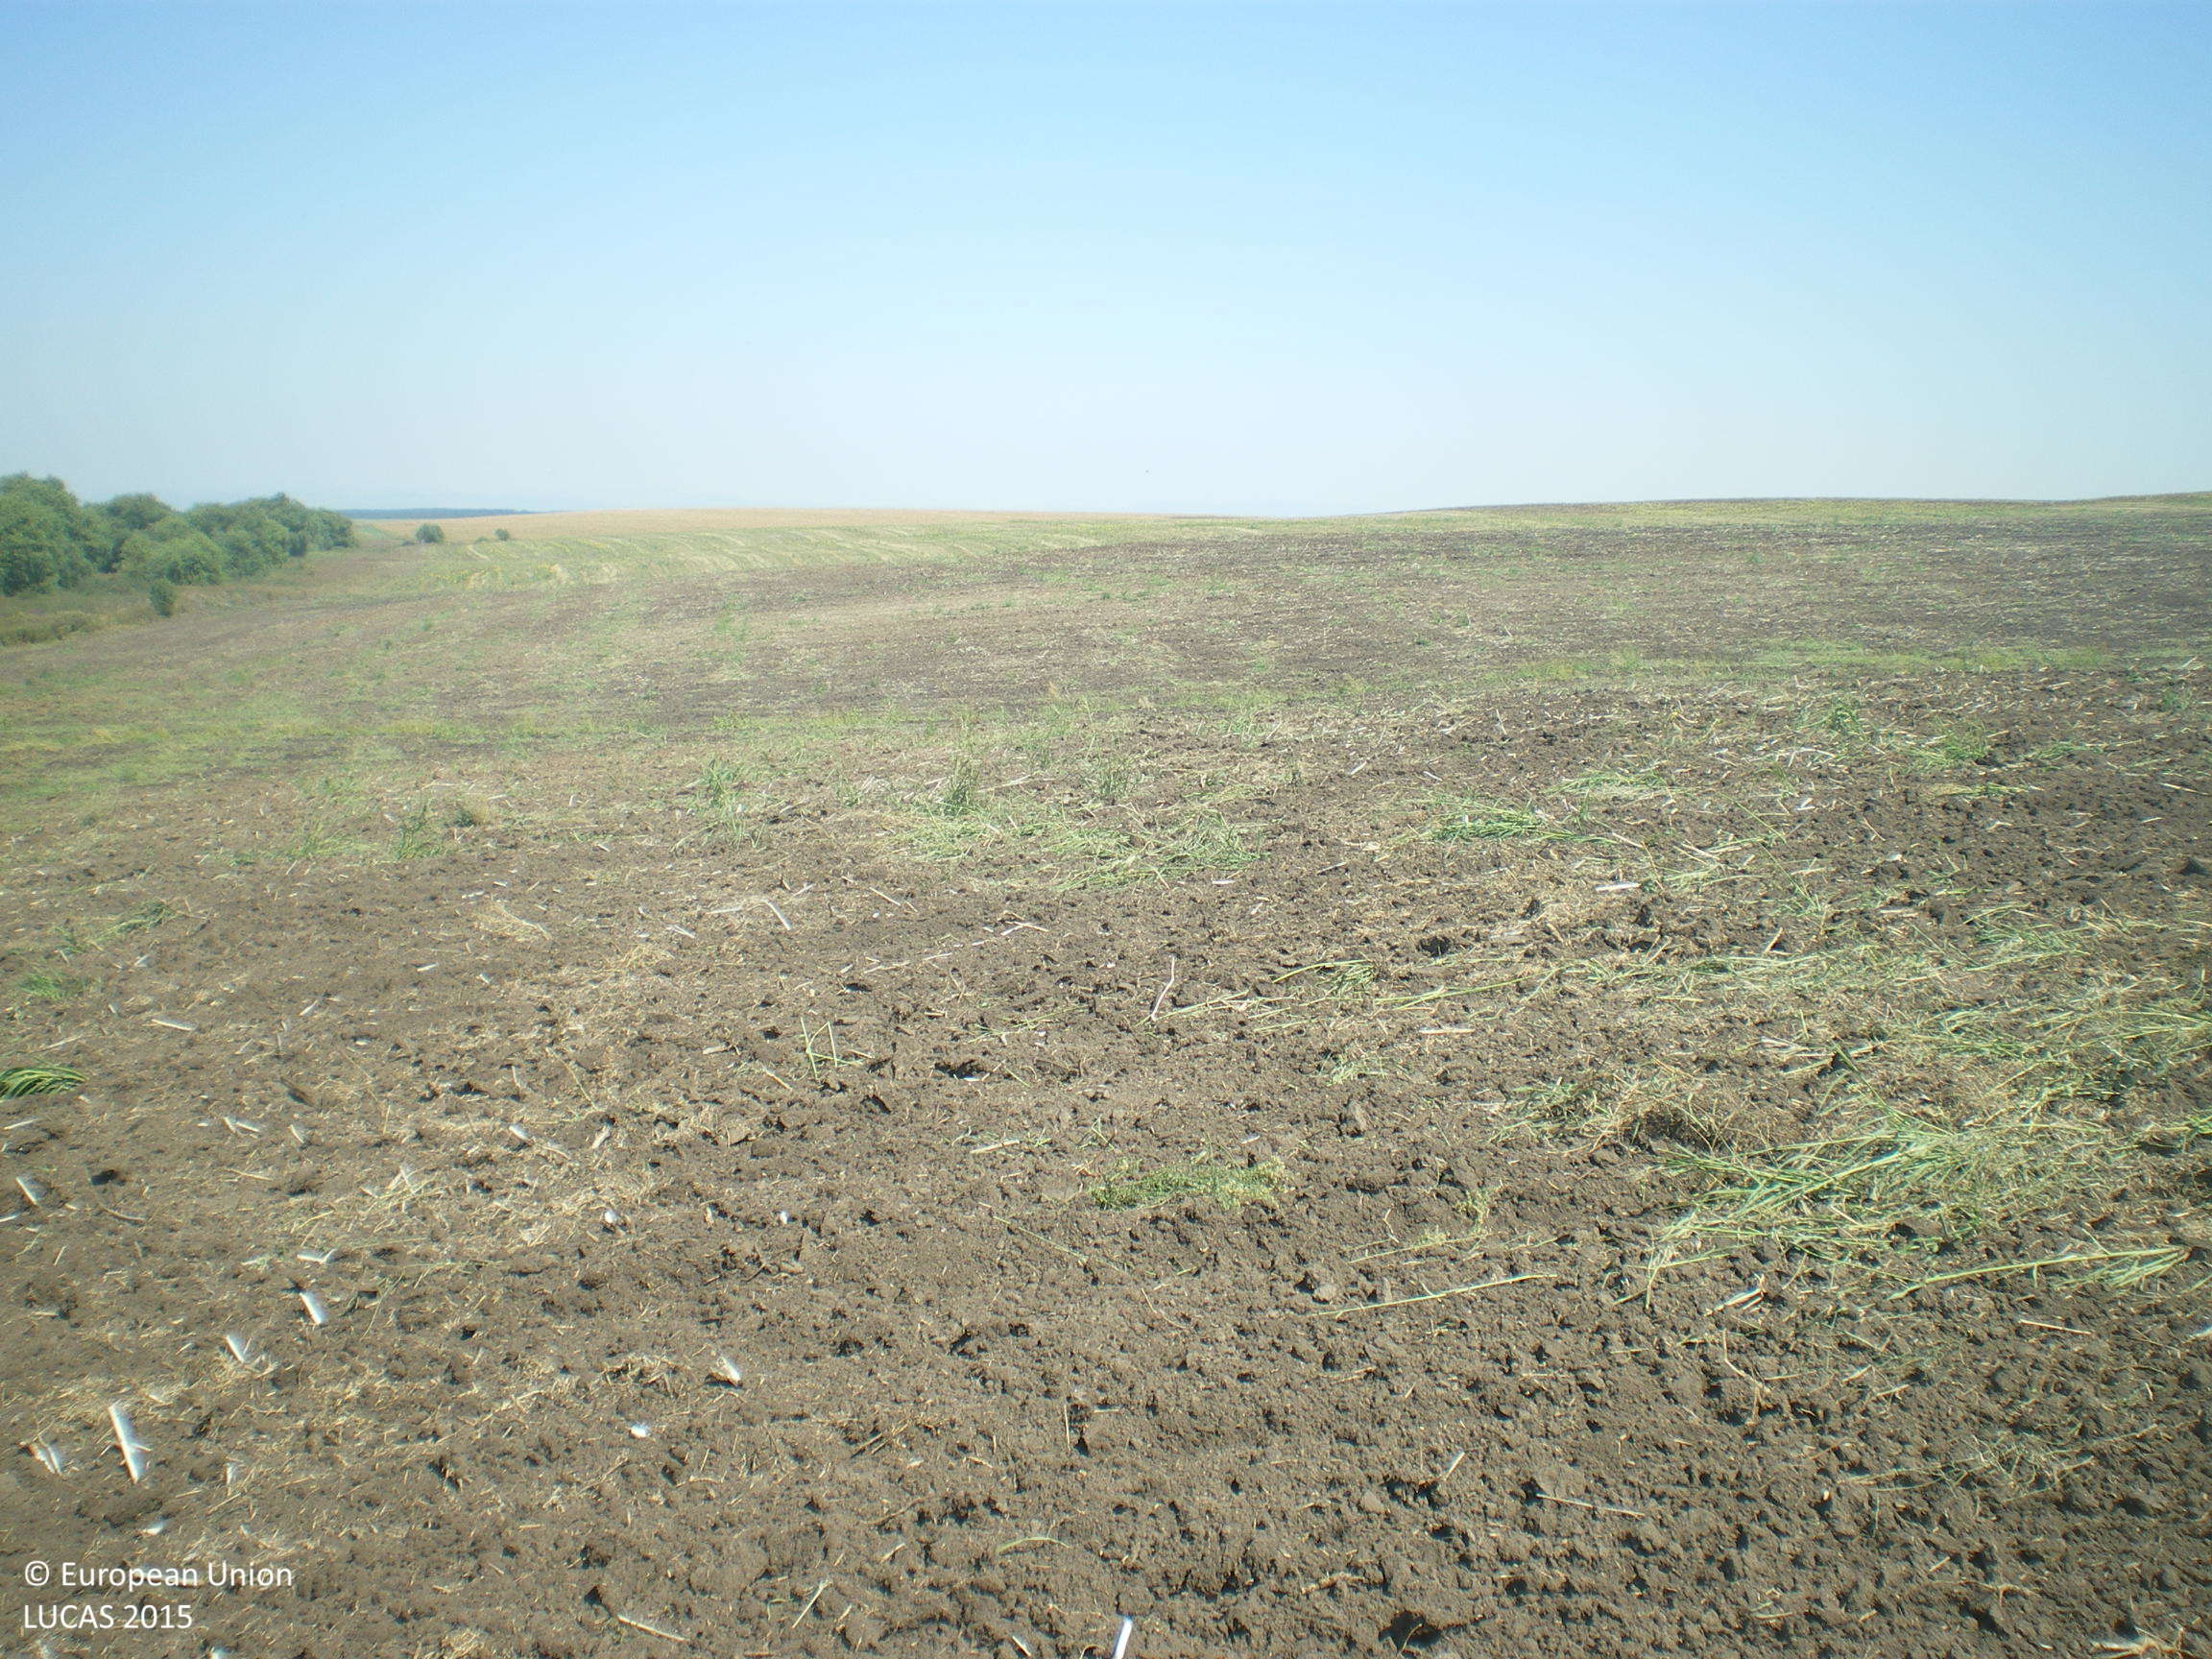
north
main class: Cropland
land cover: Rape and turnip rape
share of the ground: < 10 %
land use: Agriculture (excluding fallow land and kitchen gardens)
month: August
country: BG
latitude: 42.1423
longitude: 25.6658
